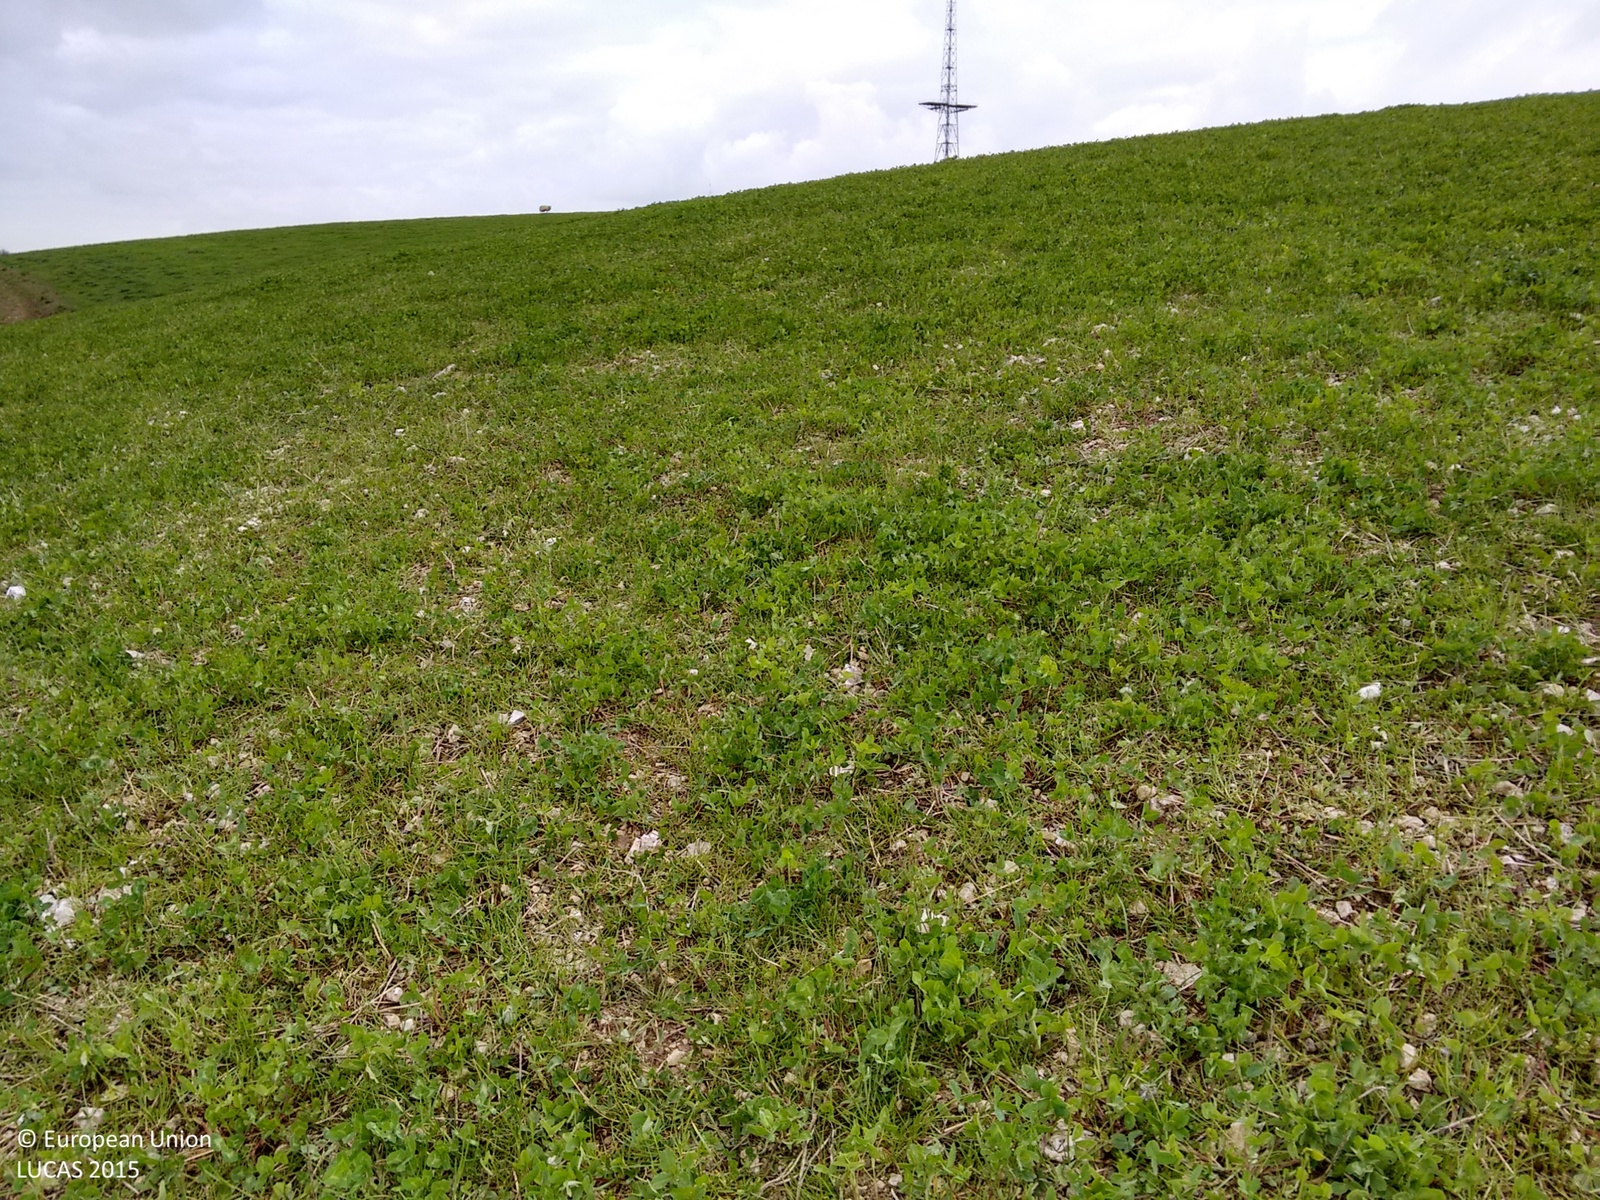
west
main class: Cropland
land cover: Clovers
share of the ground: > 75 %
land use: Agriculture (excluding fallow land and kitchen gardens)
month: May
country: GB
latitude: 53.3224
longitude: -0.1066
